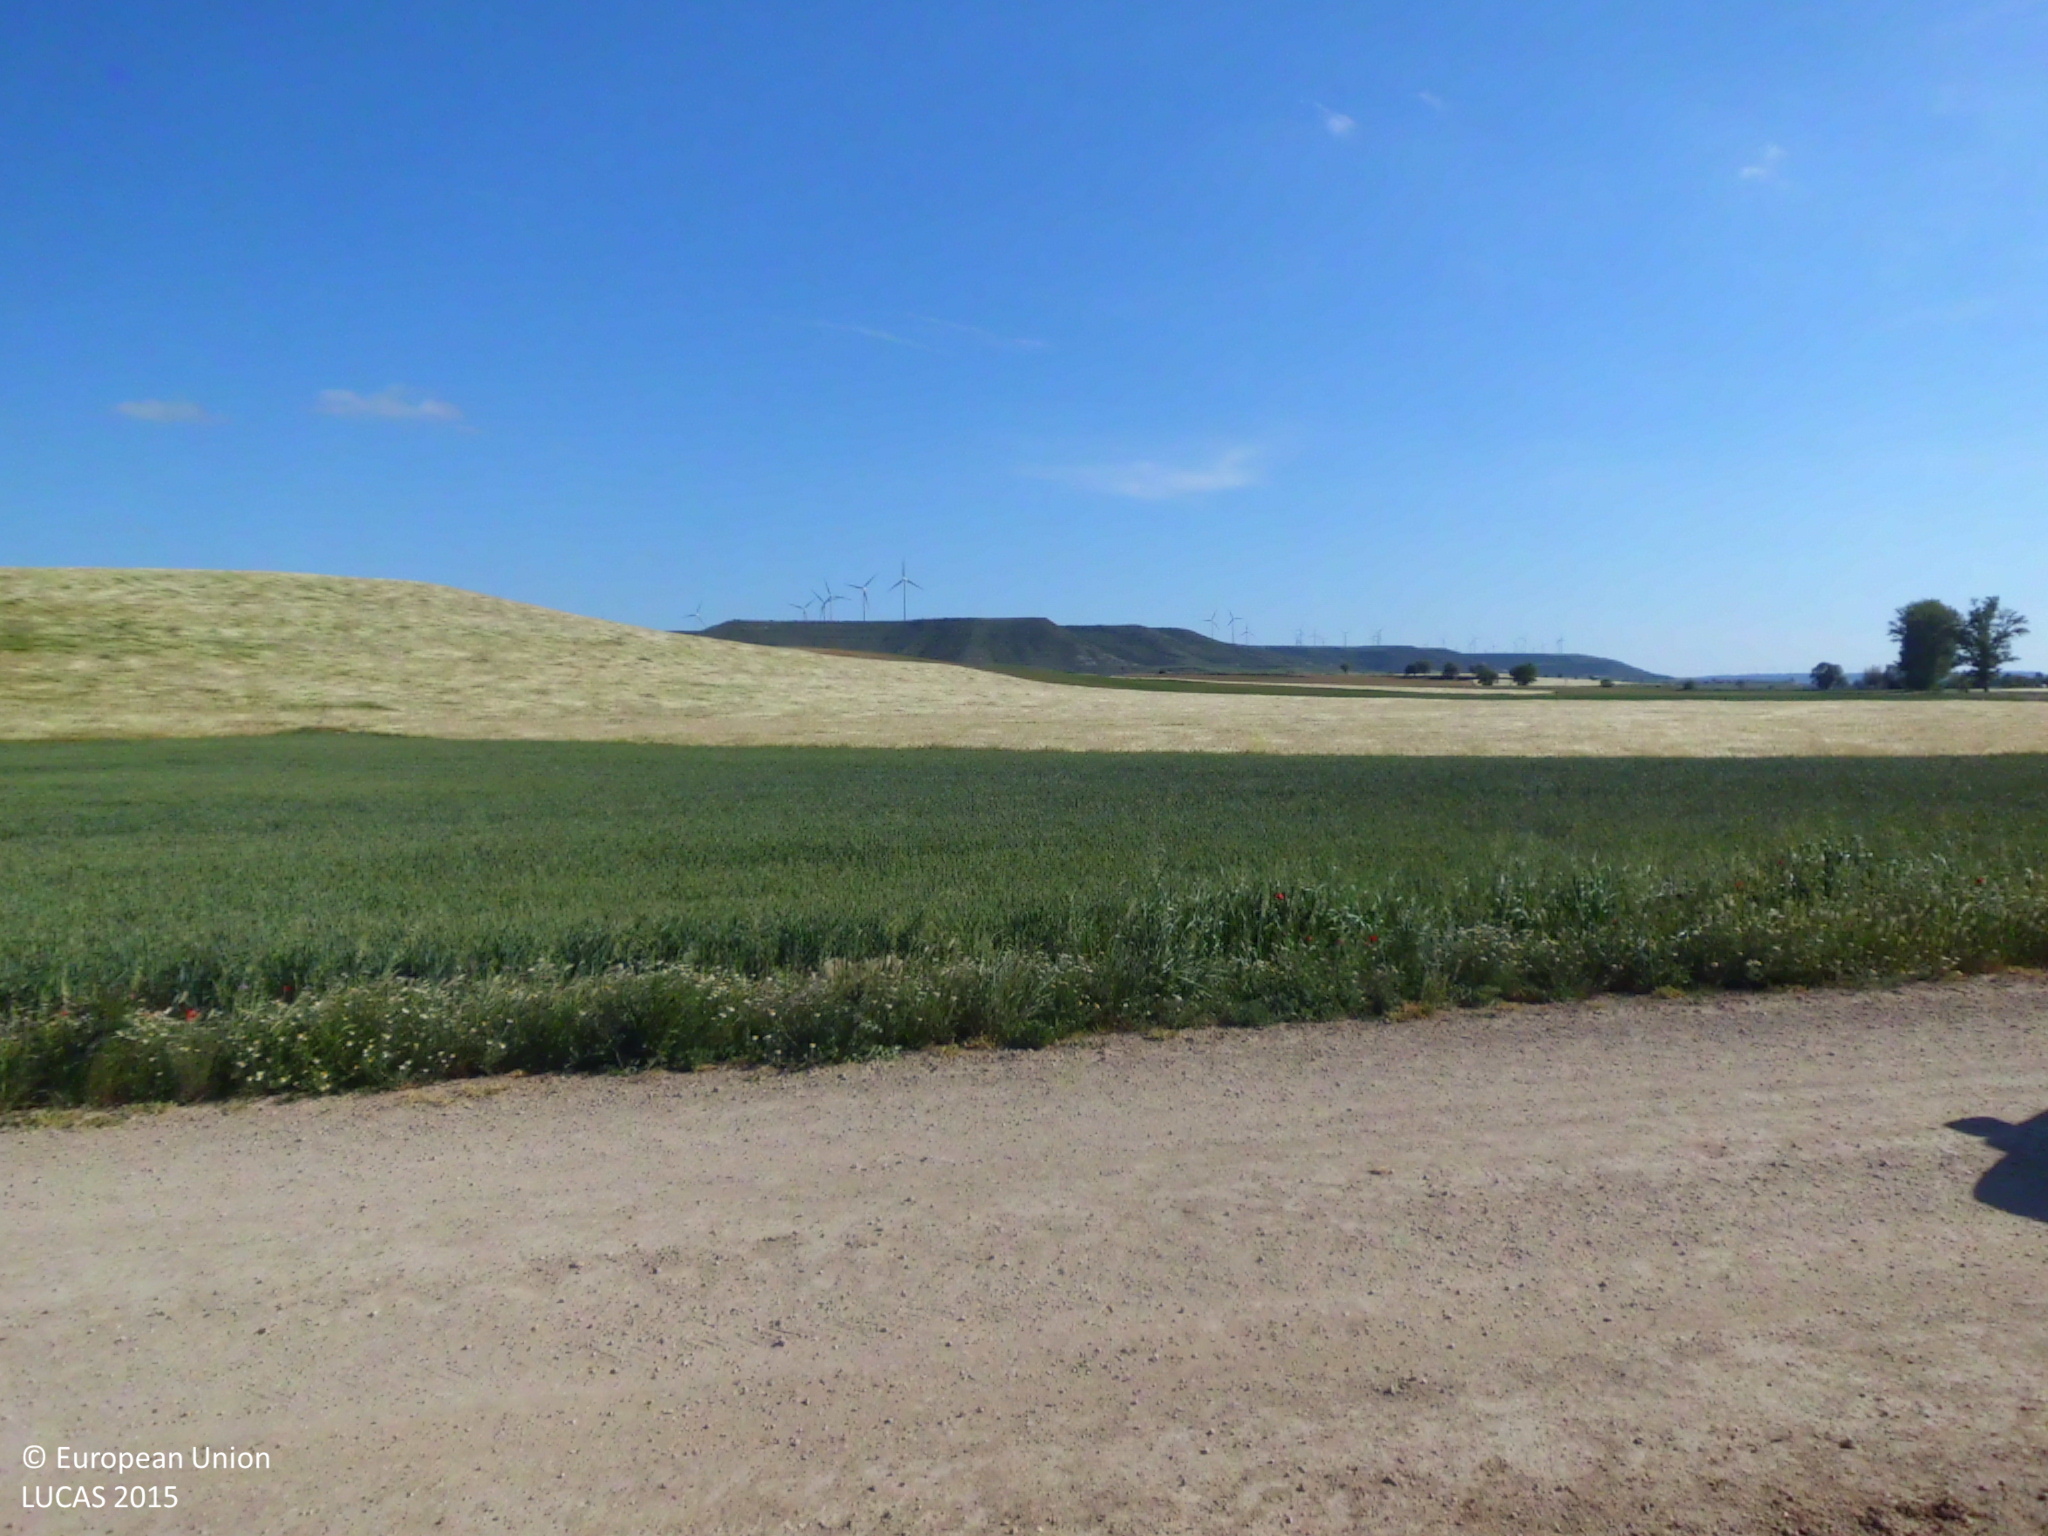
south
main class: Cropland
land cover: Common wheat
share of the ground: > 75 %
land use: Agriculture (excluding fallow land and kitchen gardens)
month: May
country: ES
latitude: 42.2747
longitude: -4.1687
